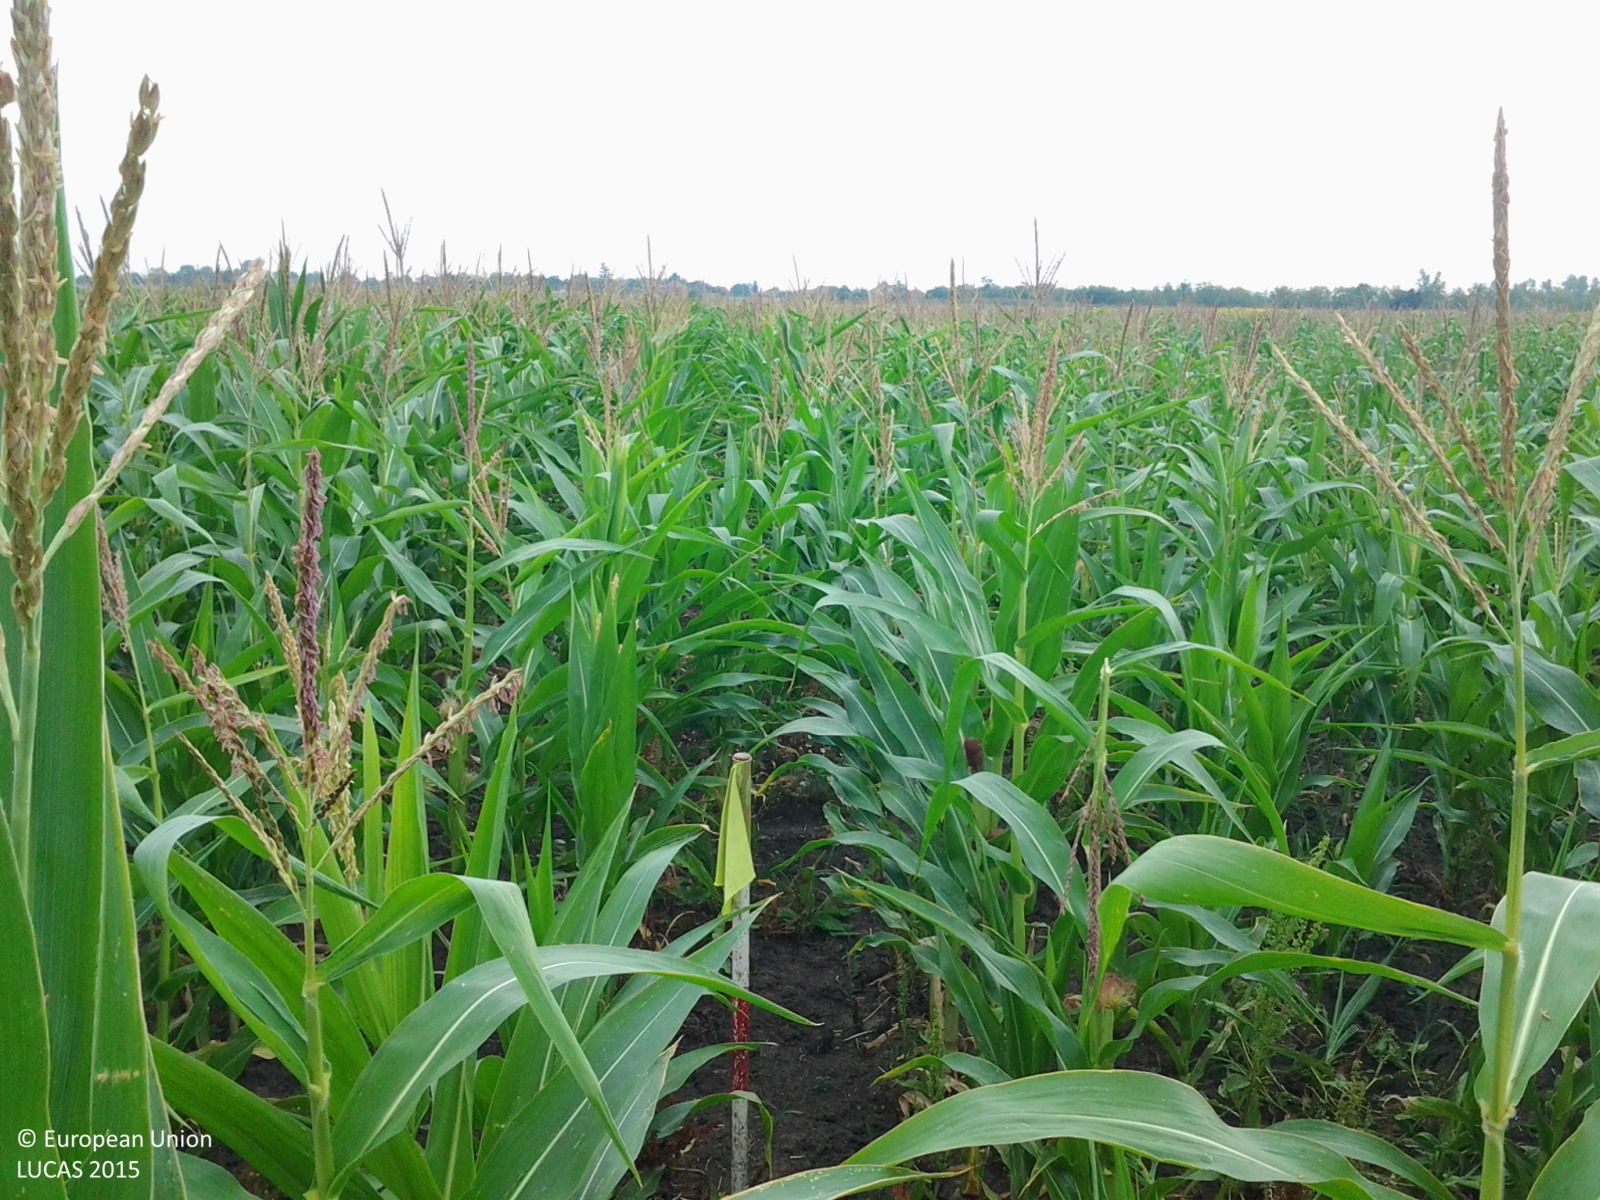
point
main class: Cropland
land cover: Maize
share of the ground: > 75 %
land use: Agriculture (excluding fallow land and kitchen gardens)
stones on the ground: < 10 %
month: August
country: HU
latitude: 47.2304
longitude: 20.5038
